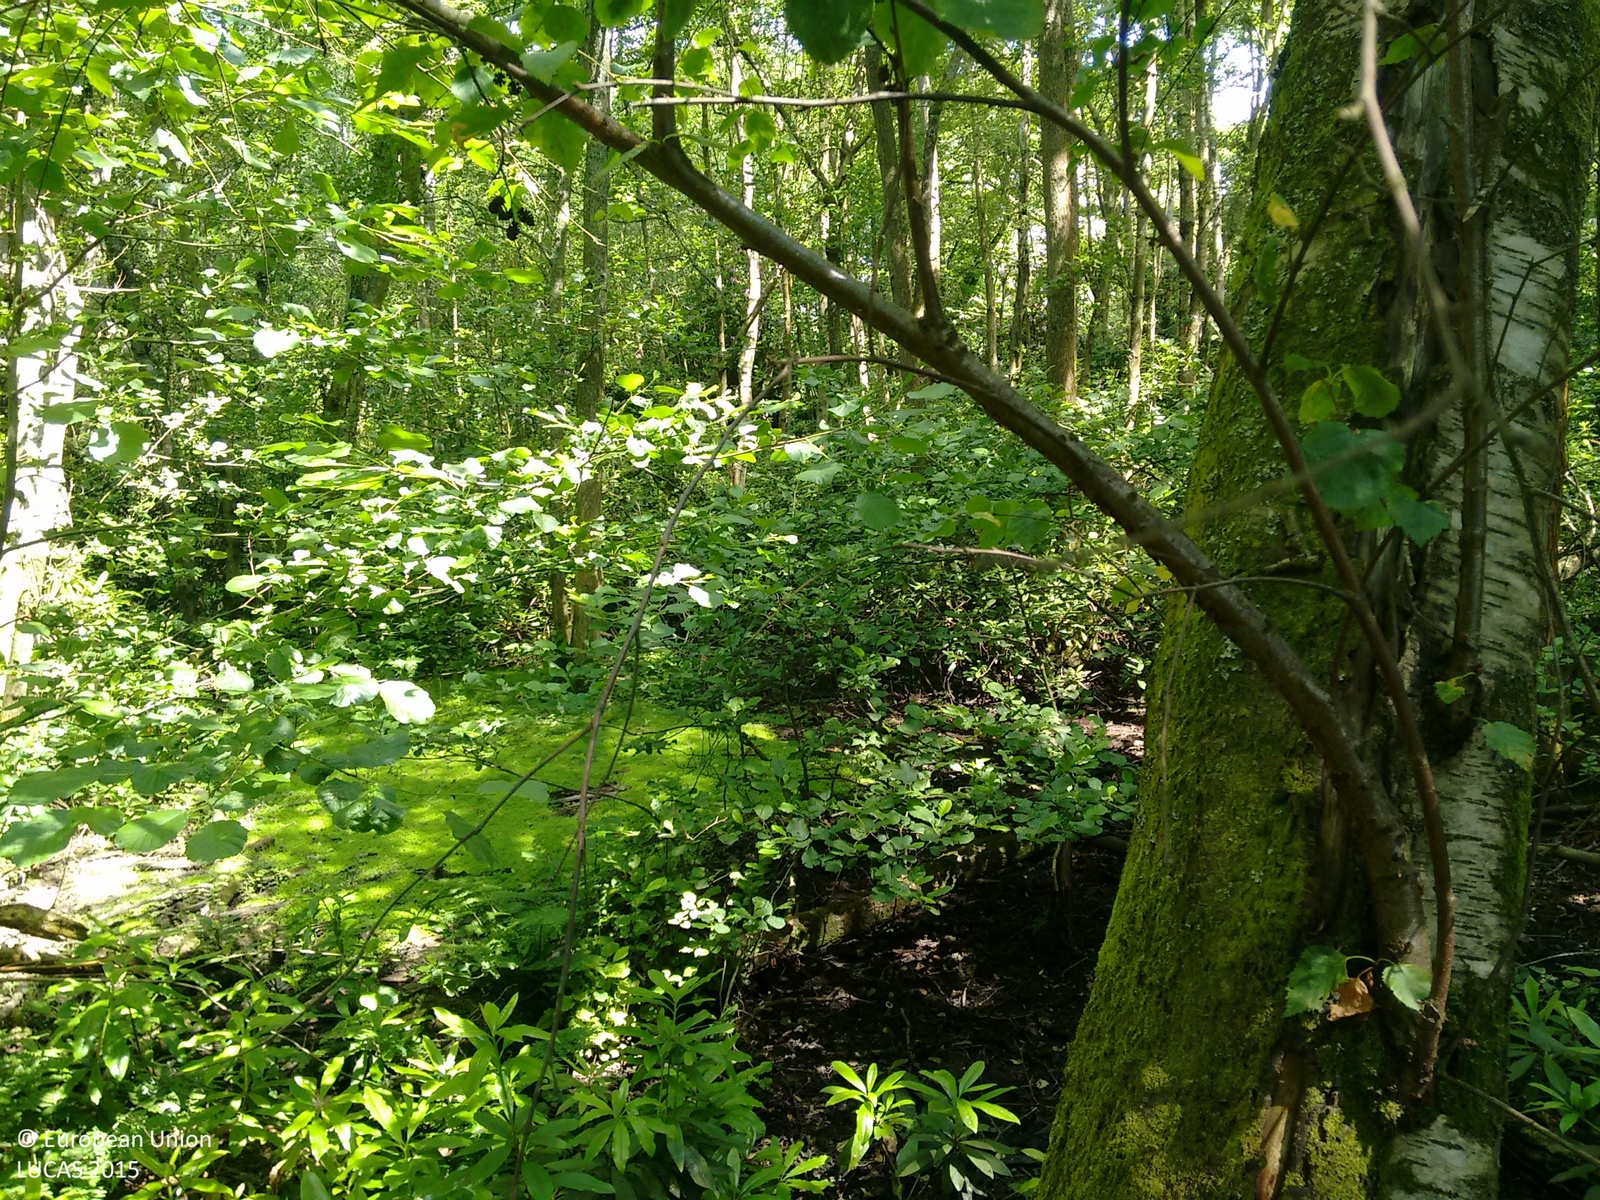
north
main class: Woodland
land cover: Broadleaved woodland
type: mesophytic deciduous forest
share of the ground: > 75 %
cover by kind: broadleaved forest trees 75 %, shrubs 25 %
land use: Semi-natural and natural areas not in use
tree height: > 5 m
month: June
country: GB
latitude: 51.1294
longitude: -0.1081
